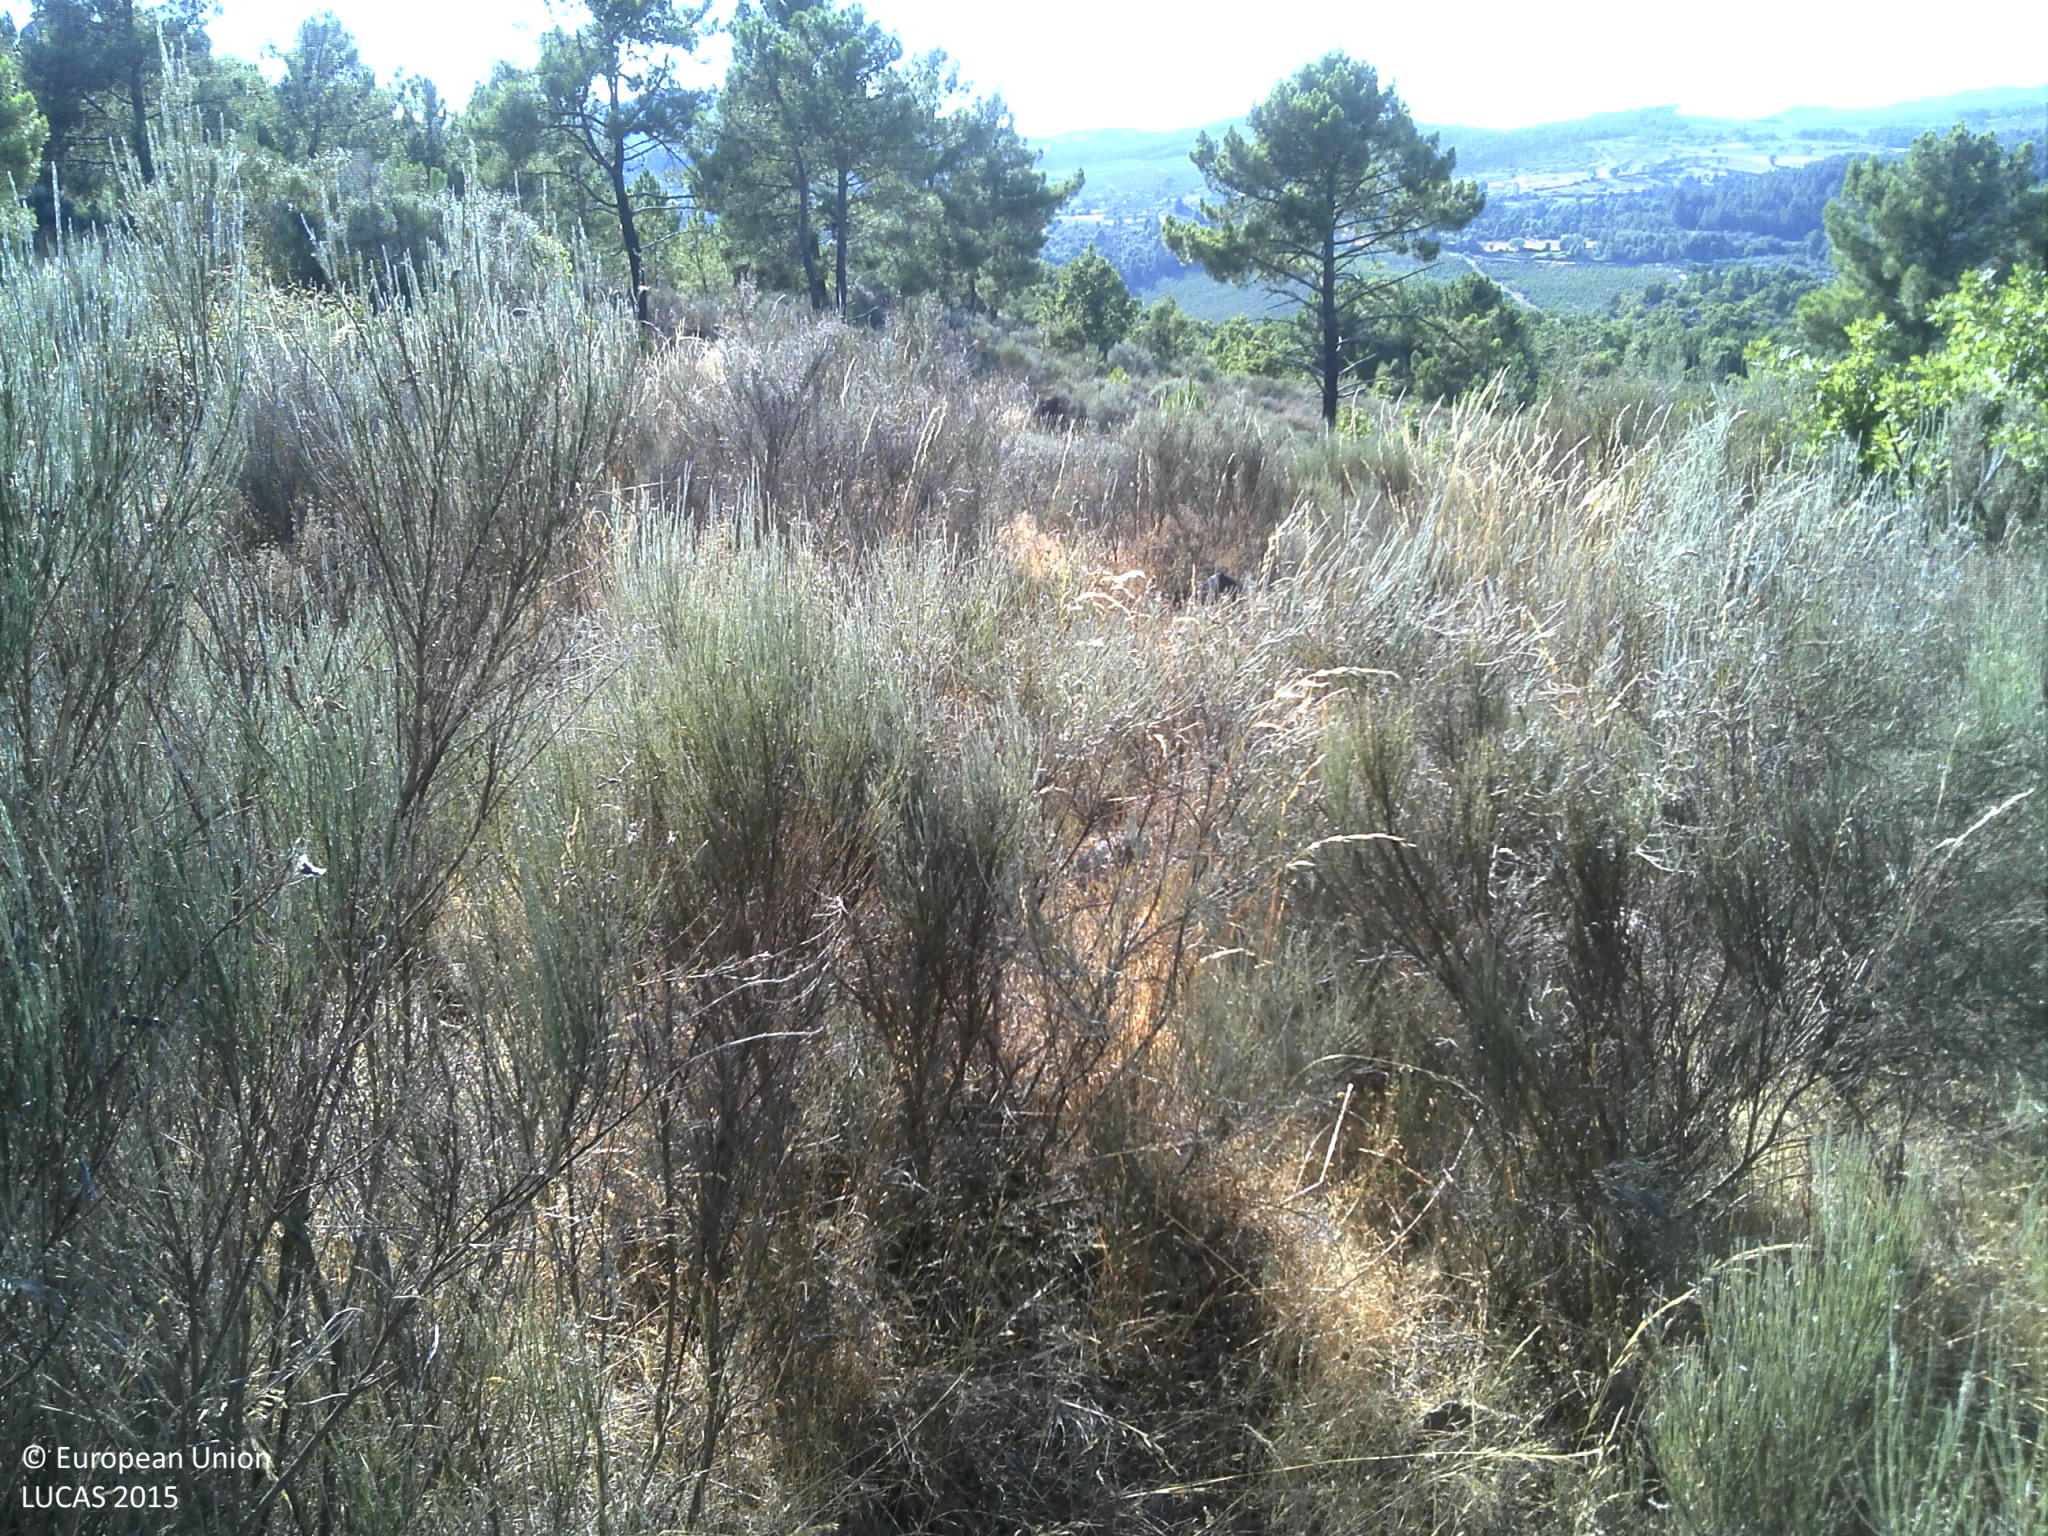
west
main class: Shrubland
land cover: Shrubland with sparse tree cover
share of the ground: > 75 %
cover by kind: shrubs 95 %, broadleaved forest trees 5 %
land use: Semi-natural and natural areas not in use
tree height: < 5 m
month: July
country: PT
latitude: 41.2068
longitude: -7.3027
